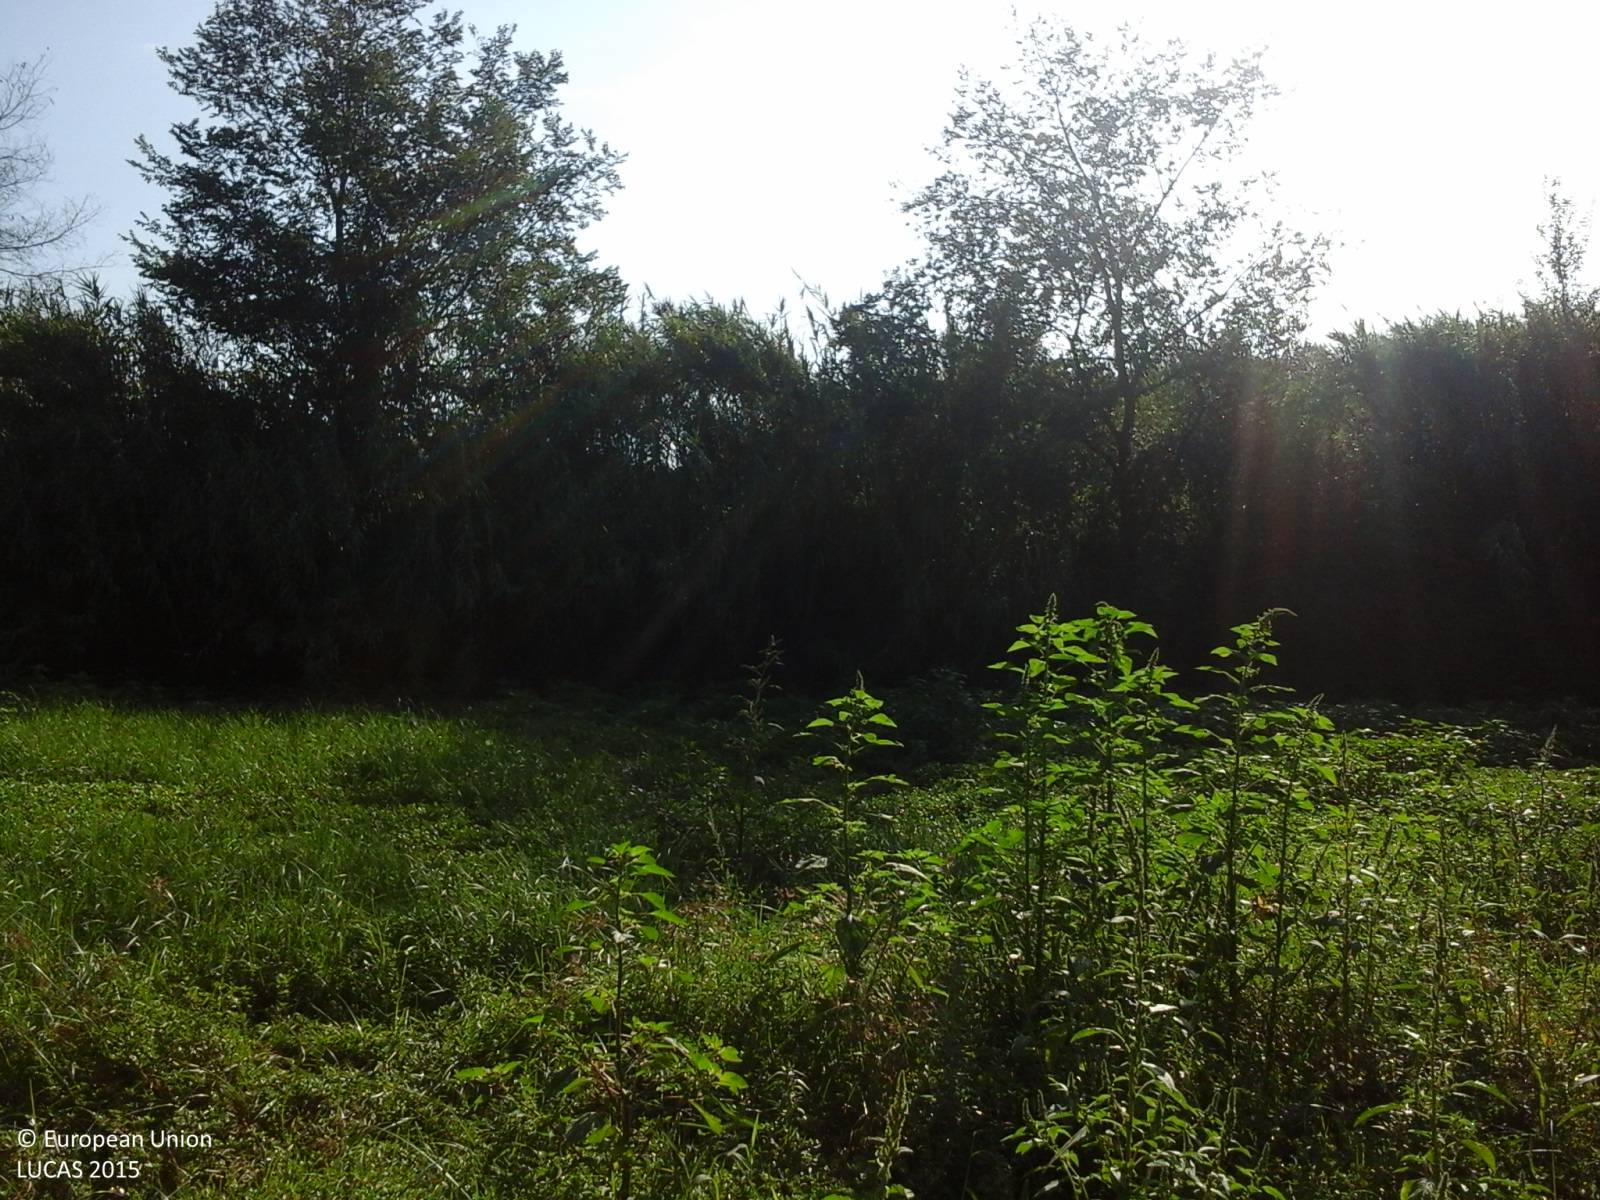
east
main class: Cropland
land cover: Other fresh vegetables
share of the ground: > 75 %
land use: Kitchen garden
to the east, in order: Other fresh vegetables; Spontaneously vegetated surfaces; Broadleaved woodland; Fences; Vineyards; Olive groves; Abandoned hedges; Tracks; Ditches and canals; Vineyards; Spontaneously vegetated surfaces
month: August
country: IT
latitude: 41.5017
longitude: 13.1623
